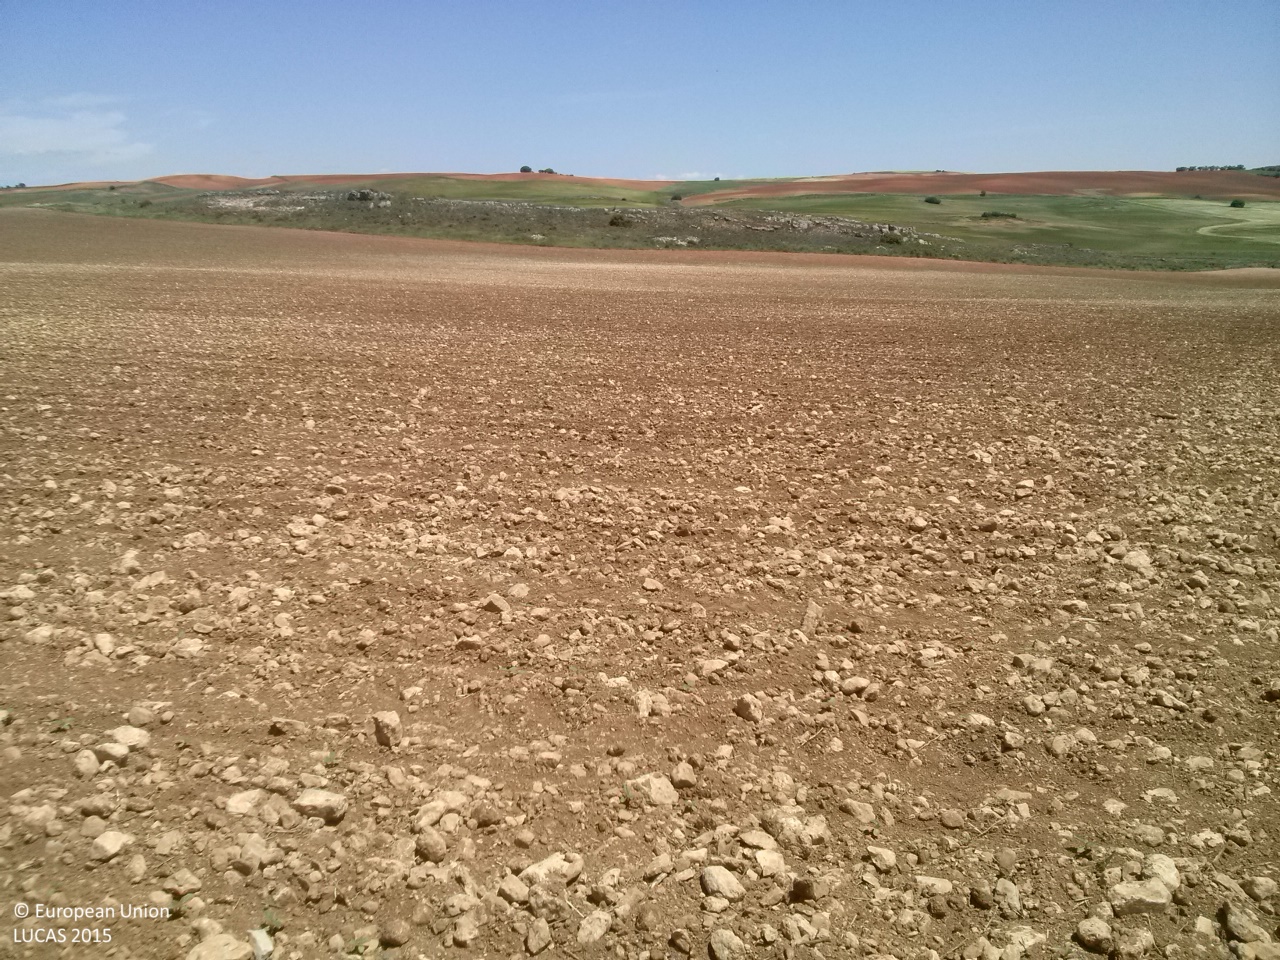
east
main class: Cropland
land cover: Sunflower
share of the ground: < 10 %
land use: Agriculture (excluding fallow land and kitchen gardens)
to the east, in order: Sunflower; Grassland without tree/shrub cover; Shrubland without tree cover; Rock outcrops; Shrubland without tree cover
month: May
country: ES
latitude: 40.0993
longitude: -2.8206
